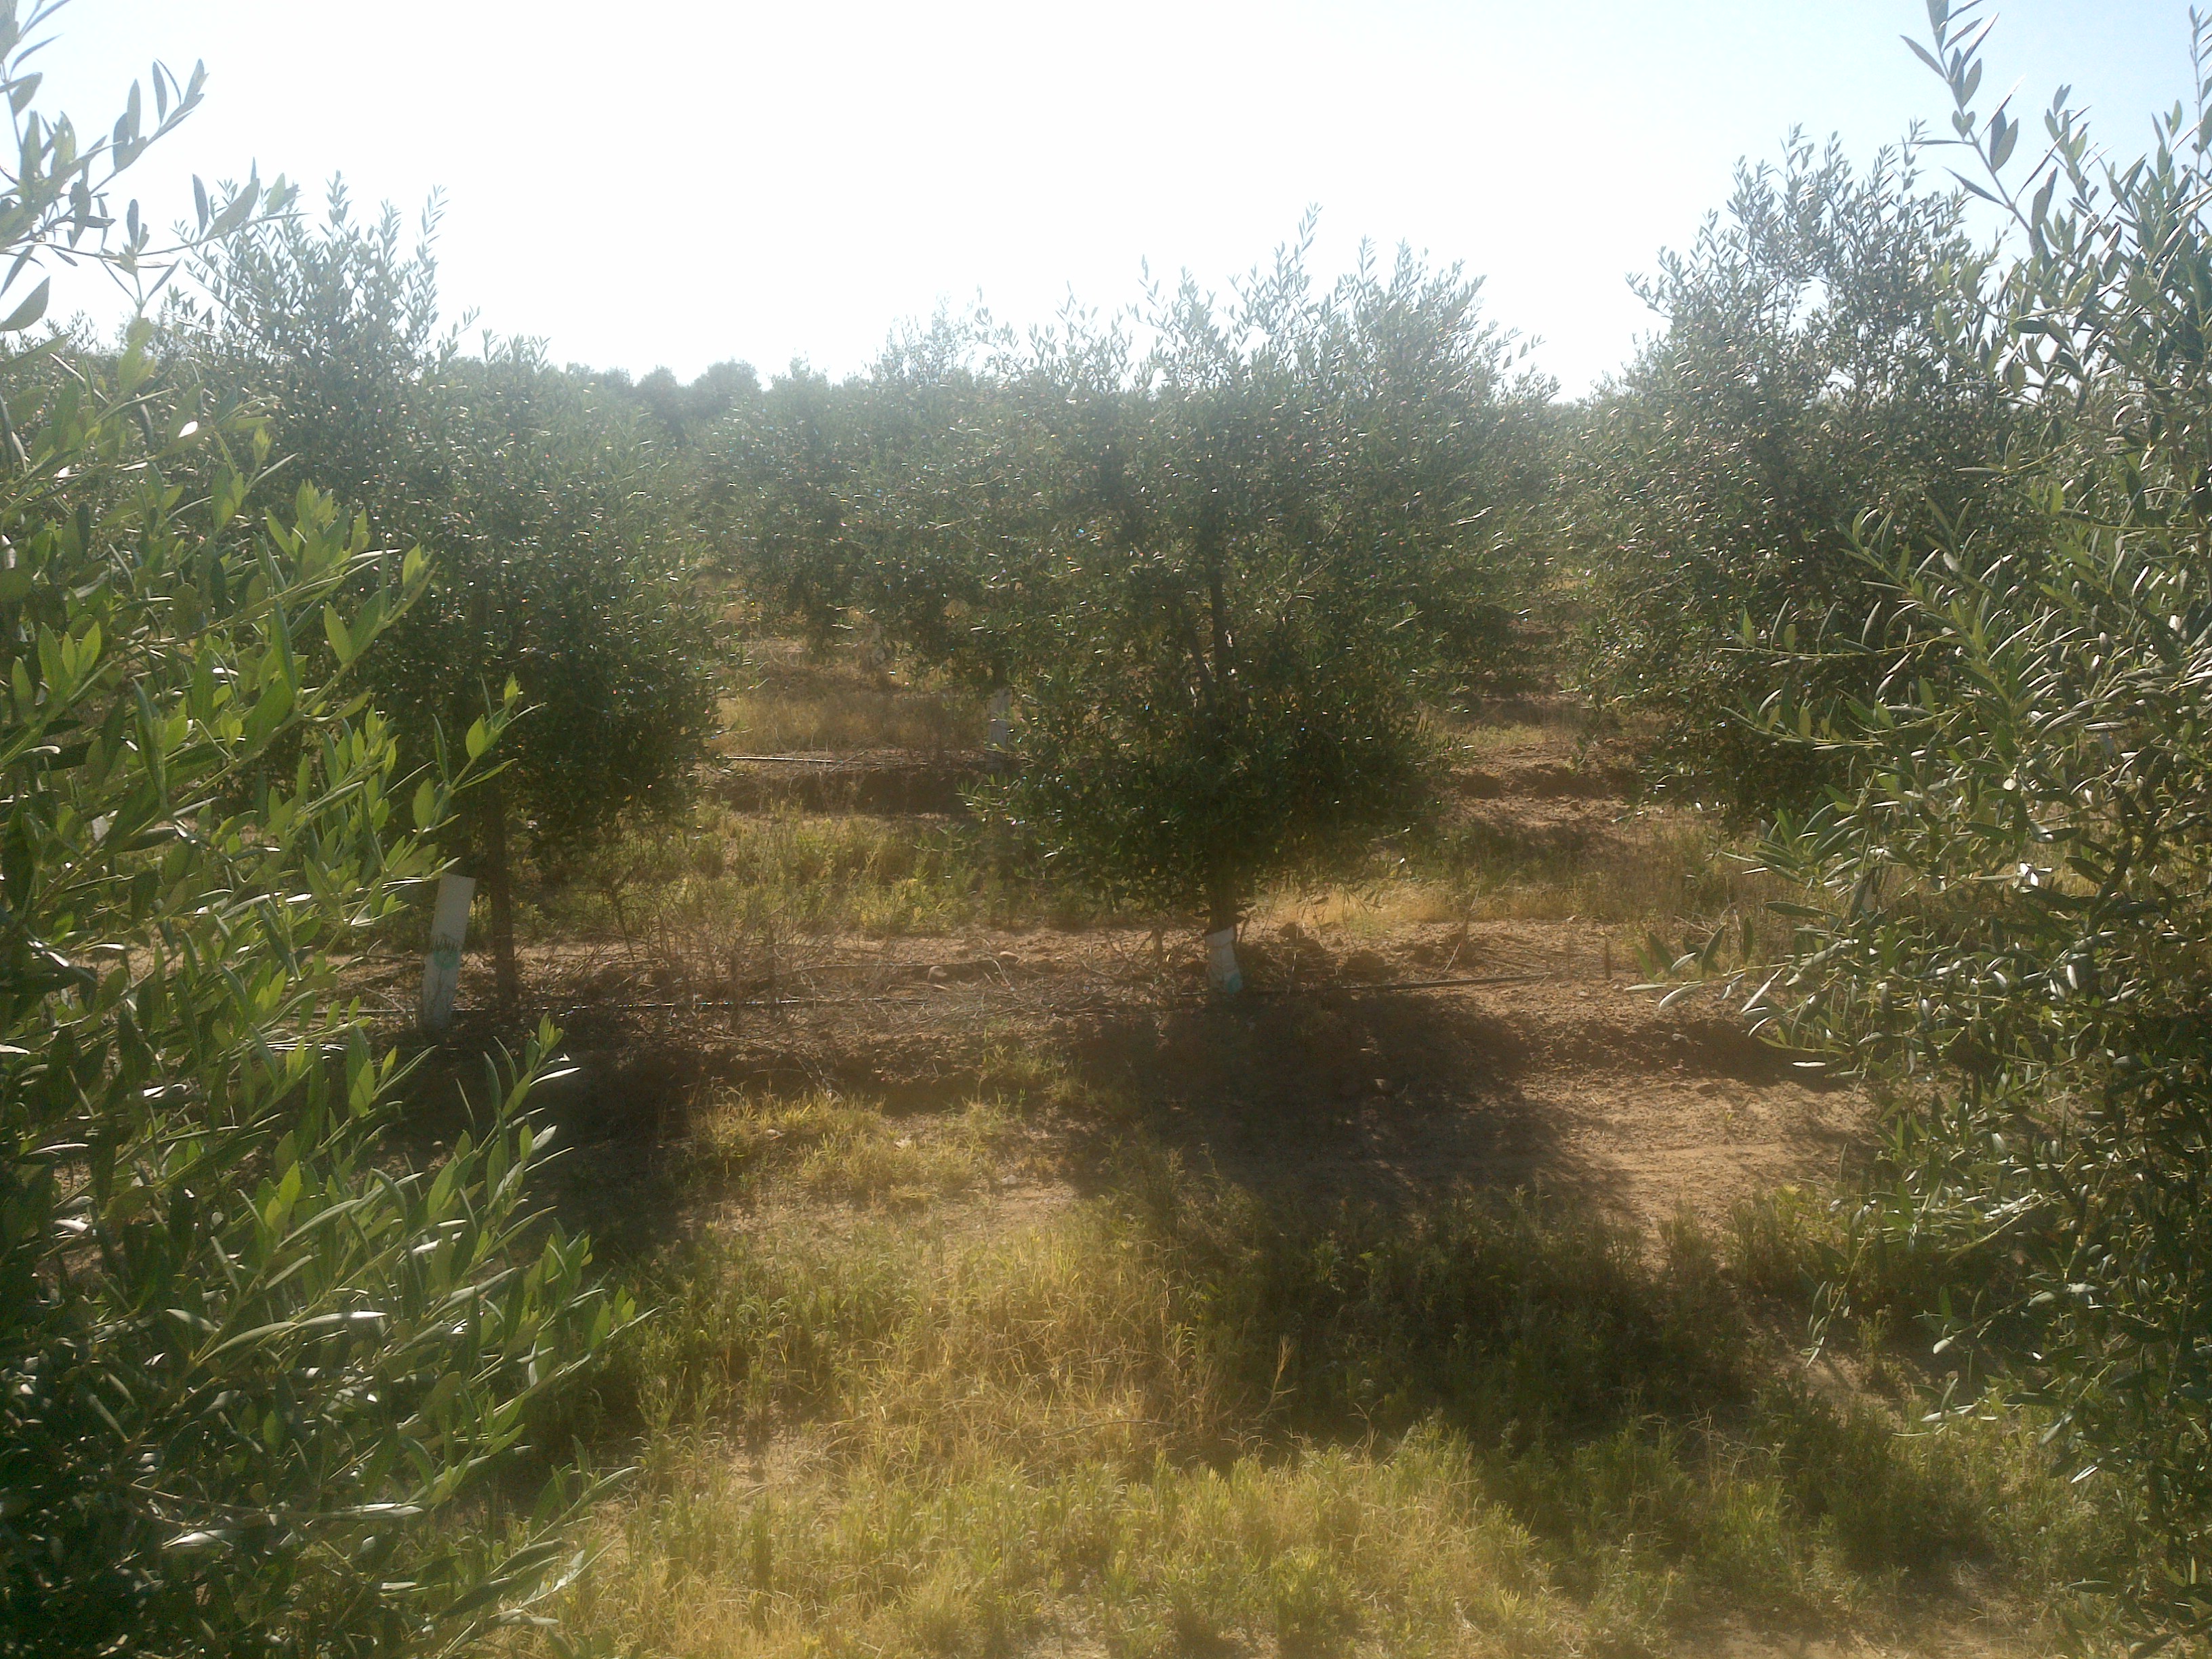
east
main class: Cropland
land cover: Olive groves
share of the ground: 25 - 50 %
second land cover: Spontaneously vegetated surfaces
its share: 10 - 25 %
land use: Agriculture (excluding fallow land and kitchen gardens)
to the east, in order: Olive groves; Spontaneously vegetated surfaces; Grass margins; Tracks; Grass margins; Olive groves; Grass margins; Olive groves; Tracks; Olive groves
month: June
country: ES
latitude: 37.6850
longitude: -5.1545
